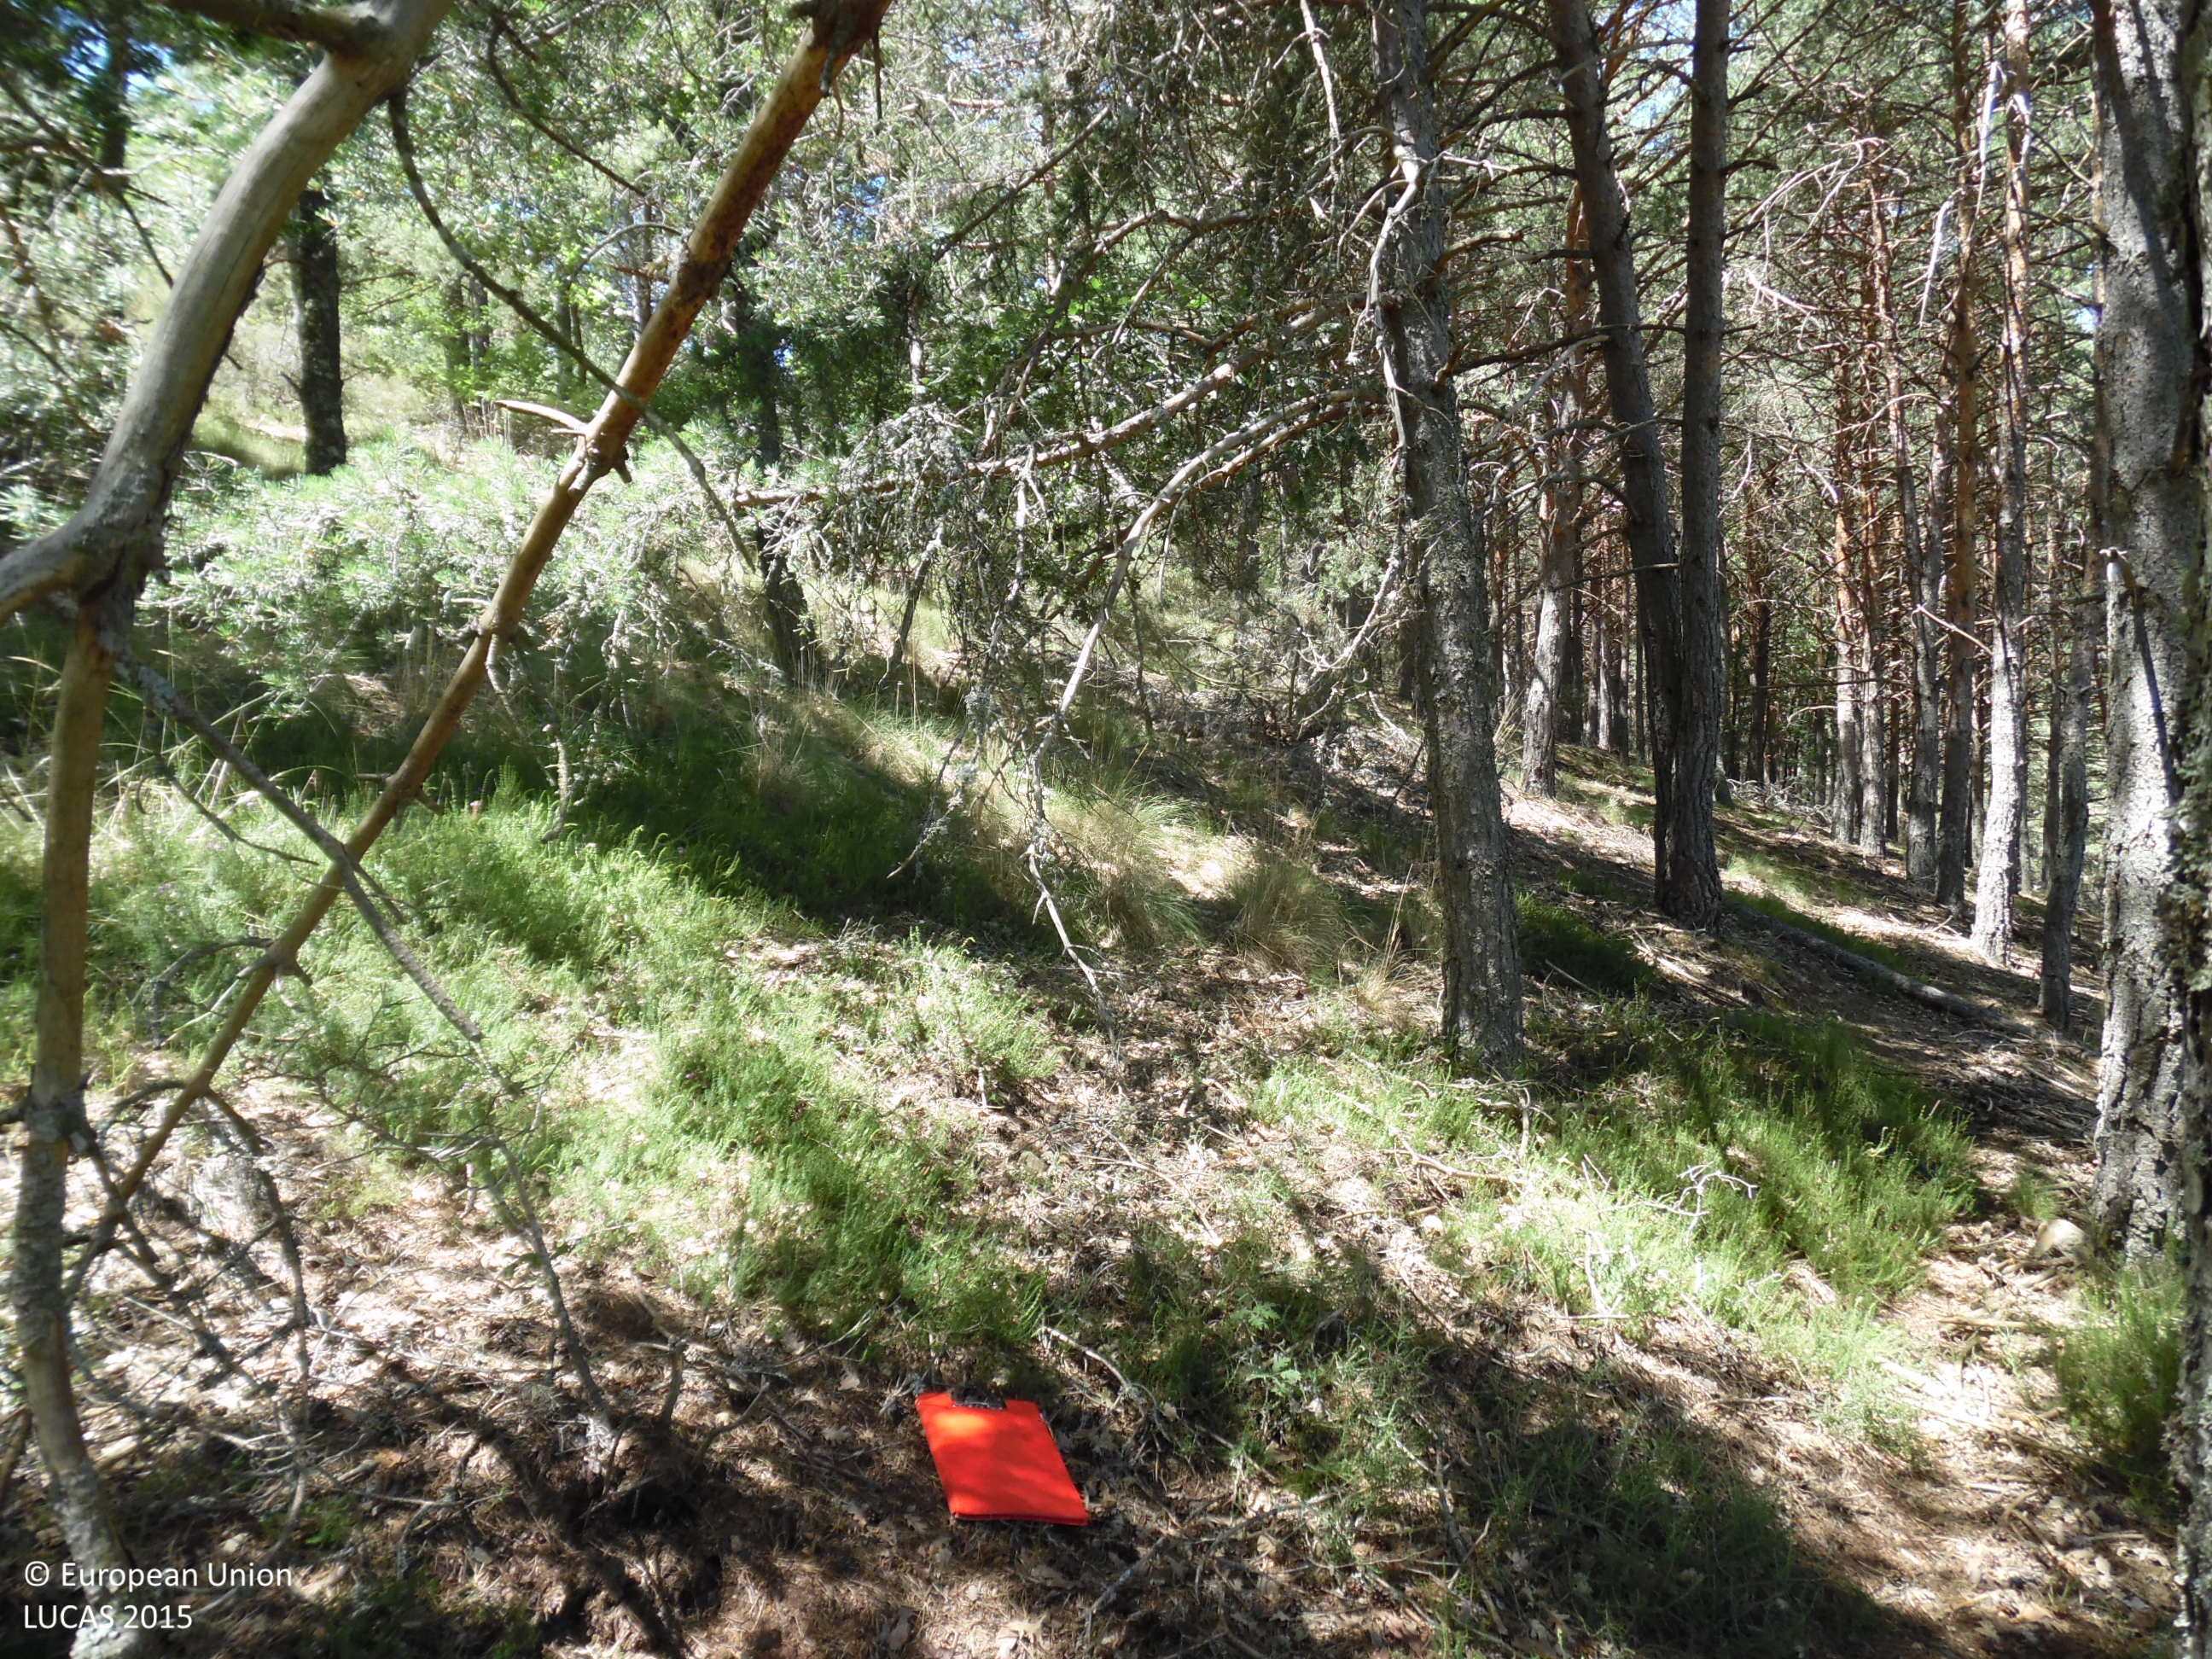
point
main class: Woodland
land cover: Pine dominated coniferous woodland
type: coniferous forest of the mediterranean region
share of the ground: 50 - 75 %
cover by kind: coniferous forest trees 95 %, shrubs 5 %
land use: Forestry
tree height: > 5 m
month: June
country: ES
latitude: 42.5433
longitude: -6.1460
